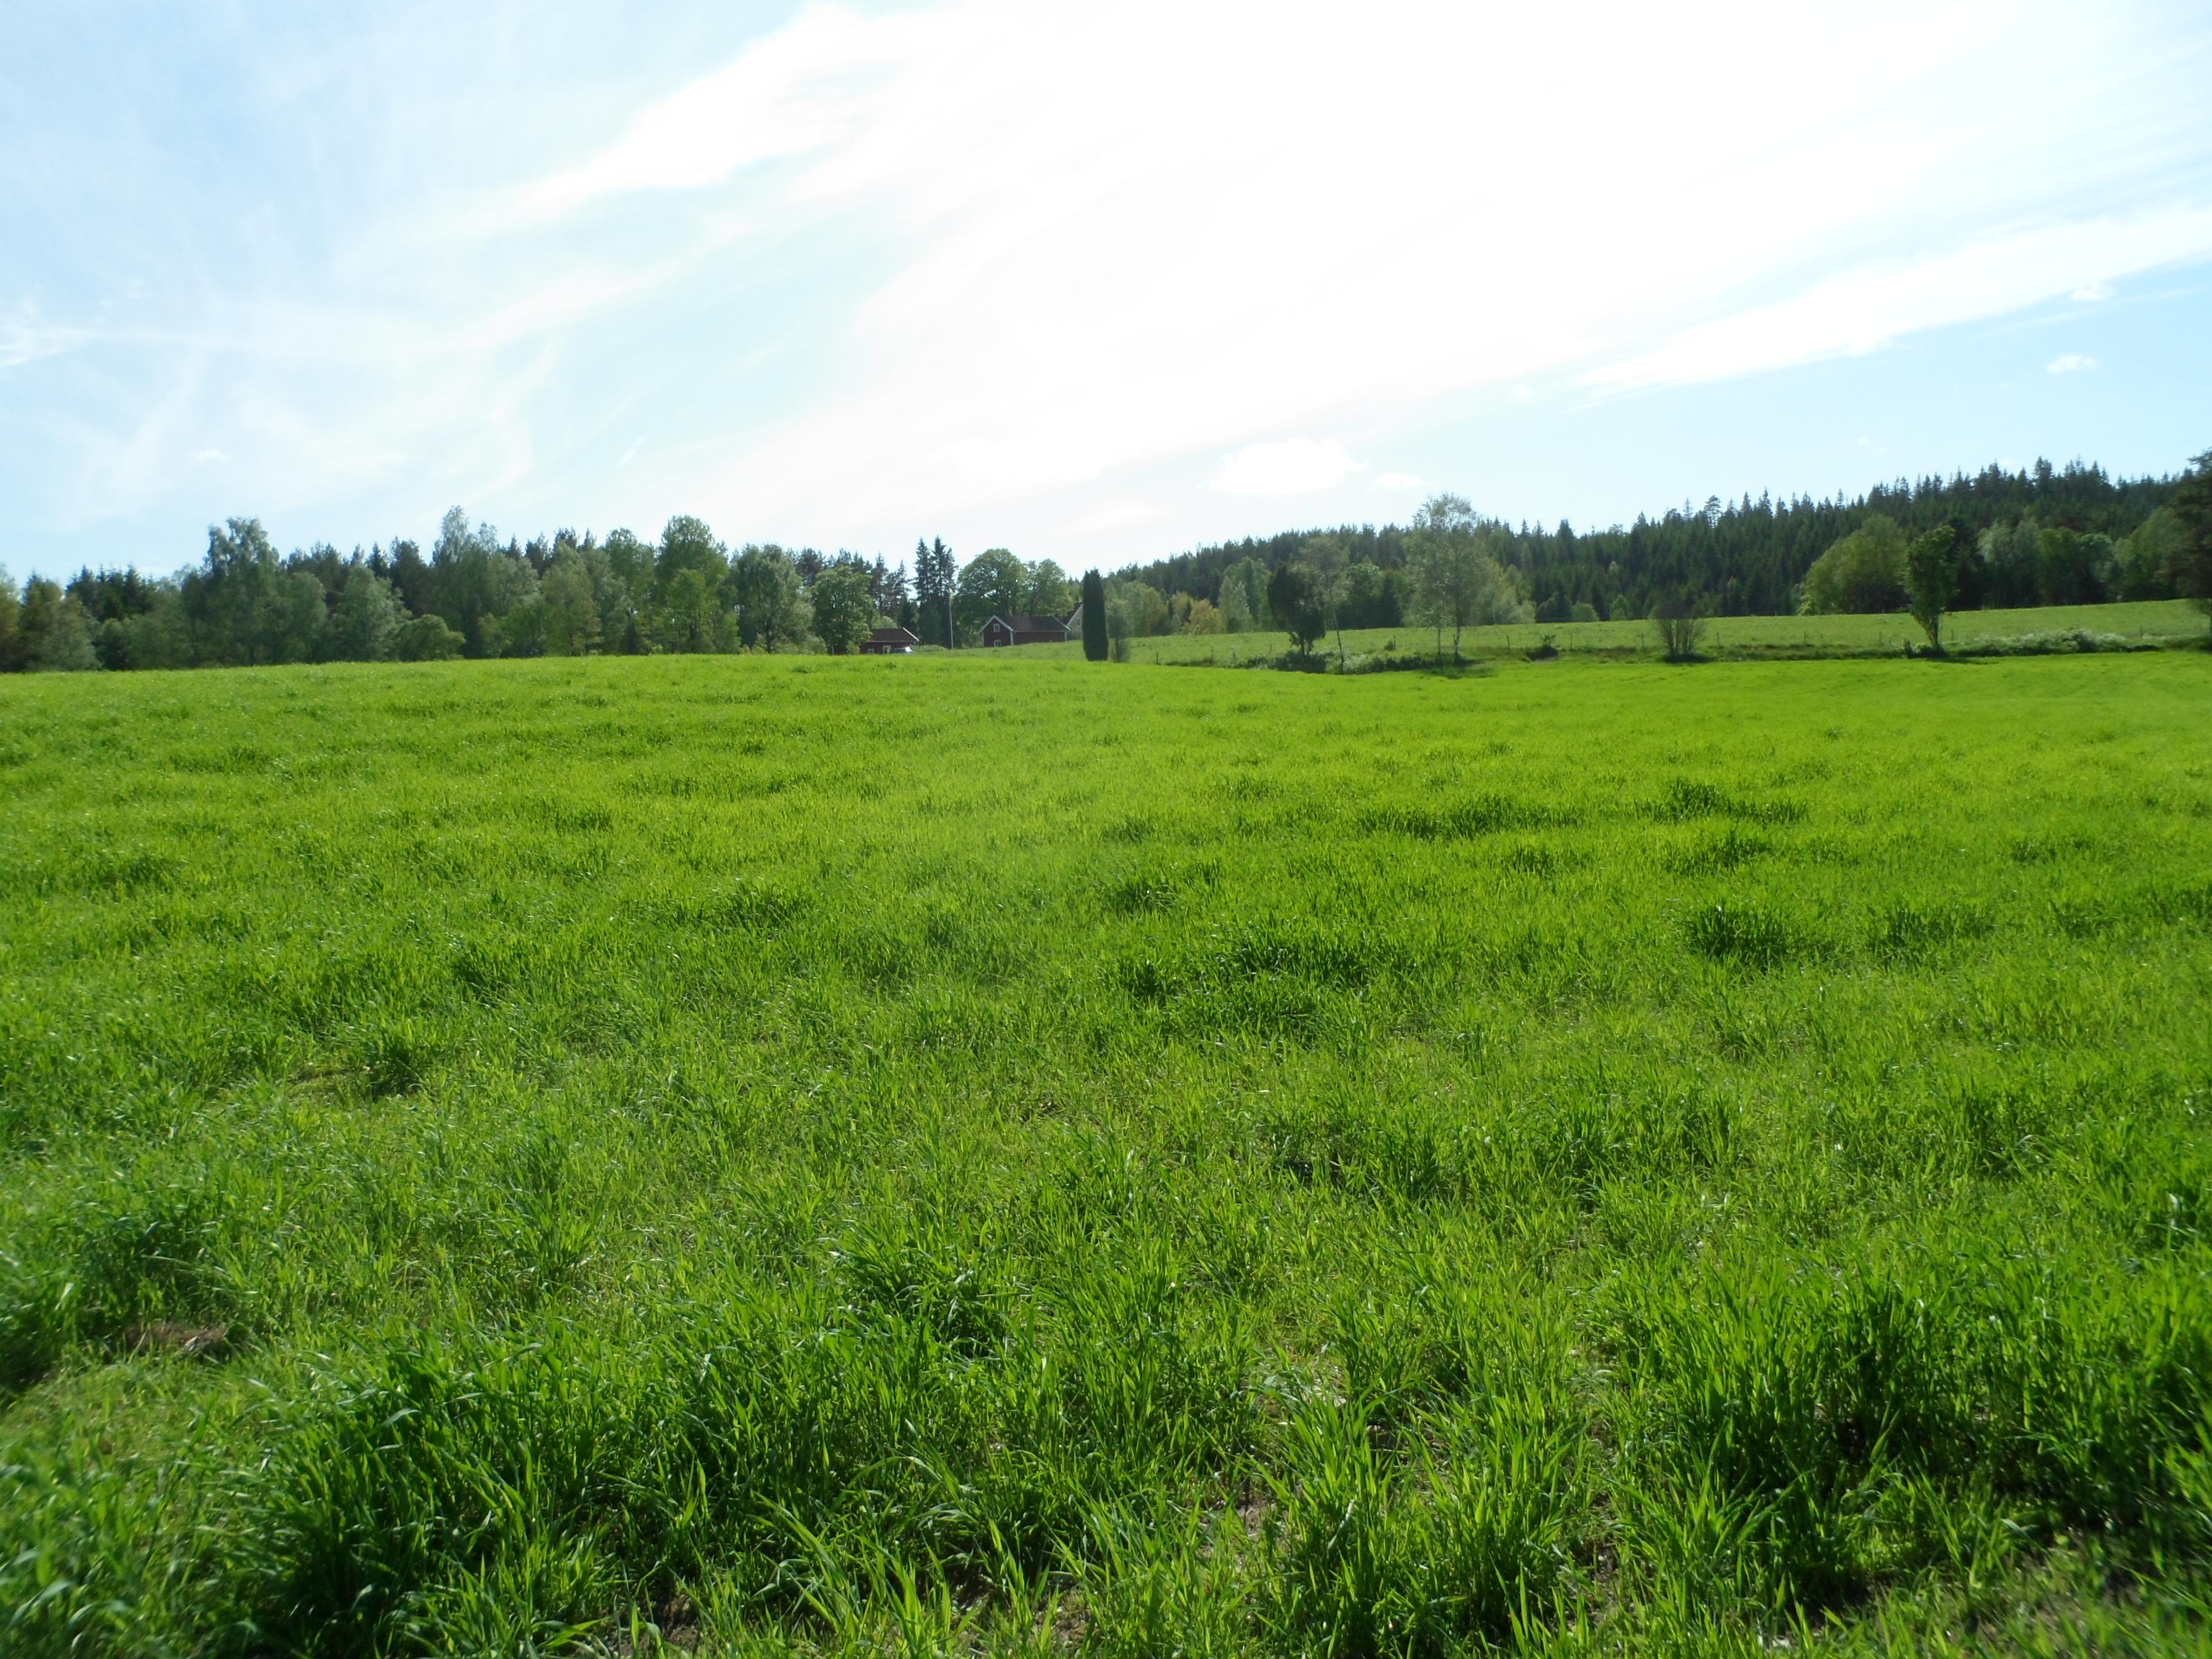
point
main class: Cropland
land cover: Barley
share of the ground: > 75 %
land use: Agriculture (excluding fallow land and kitchen gardens)
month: June
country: SE
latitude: 57.4659
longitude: 14.3136
